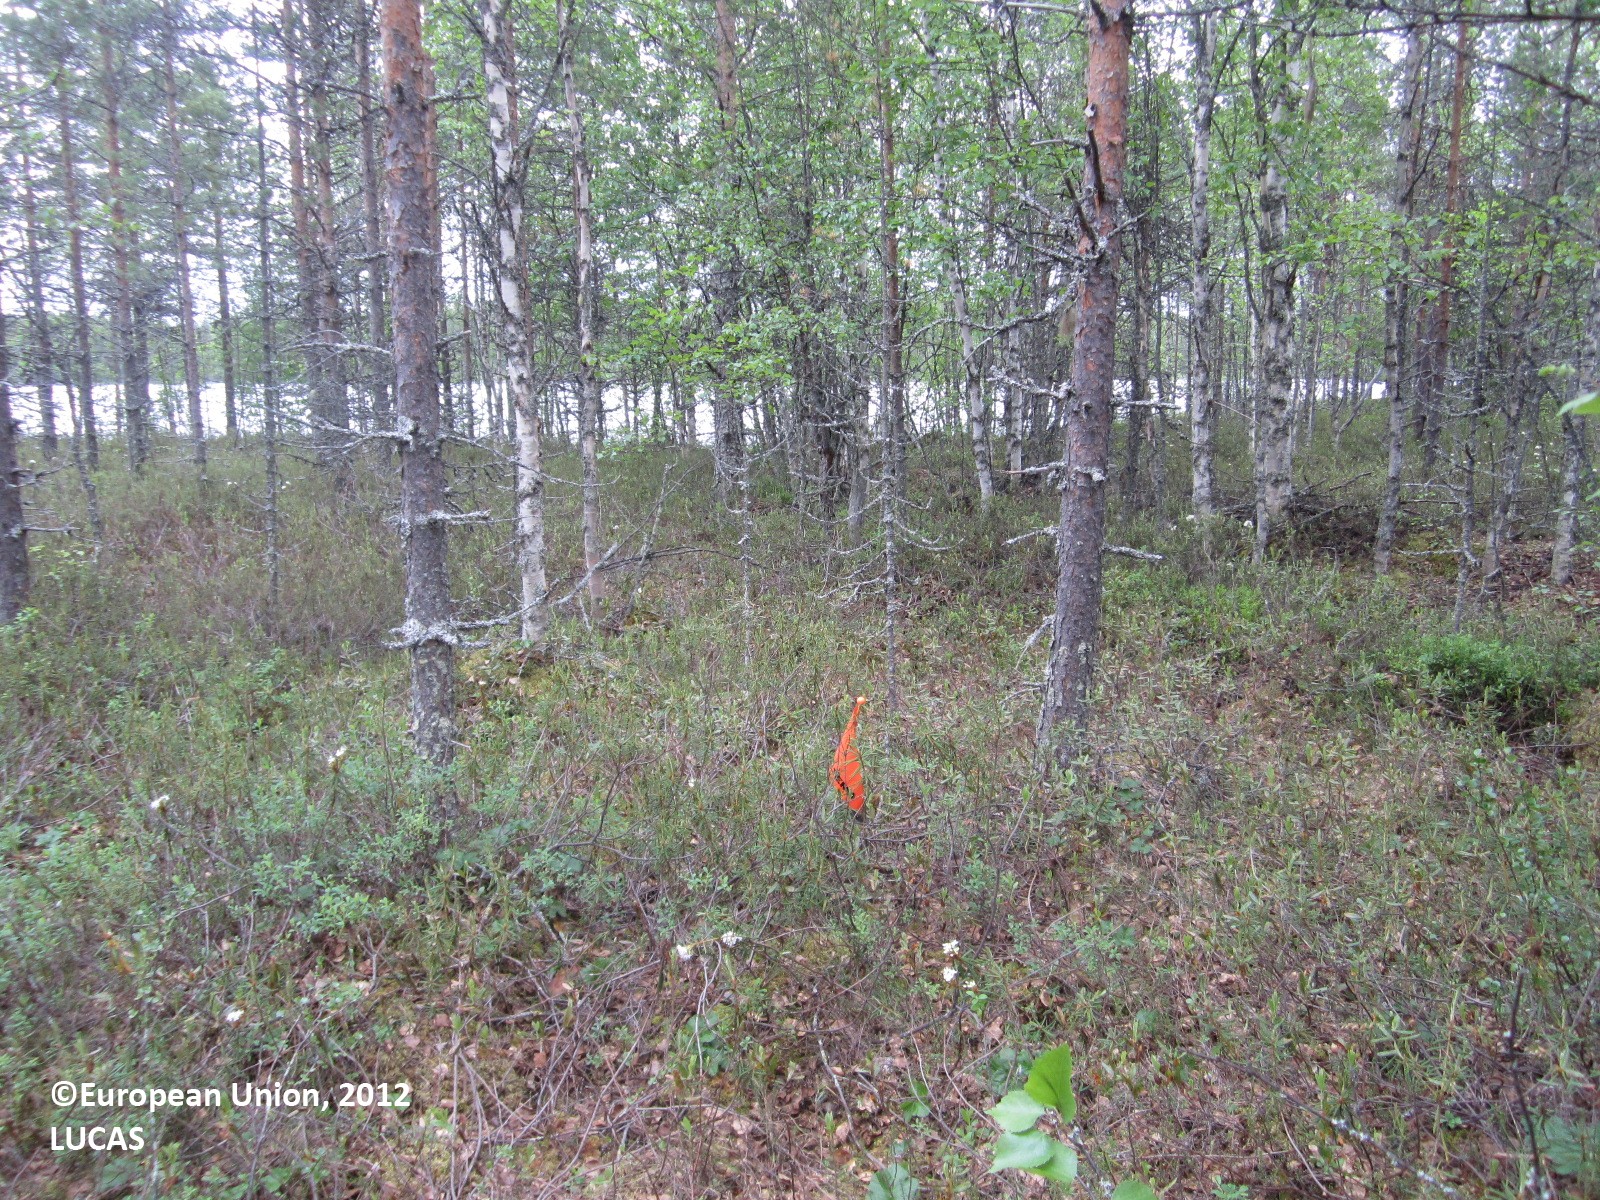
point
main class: Woodland
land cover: Pine dominated coniferous woodland
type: boreal forest
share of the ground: 50 - 75 %
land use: Forestry
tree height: > 5 m
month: June
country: FI
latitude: 64.4358
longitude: 29.5532
